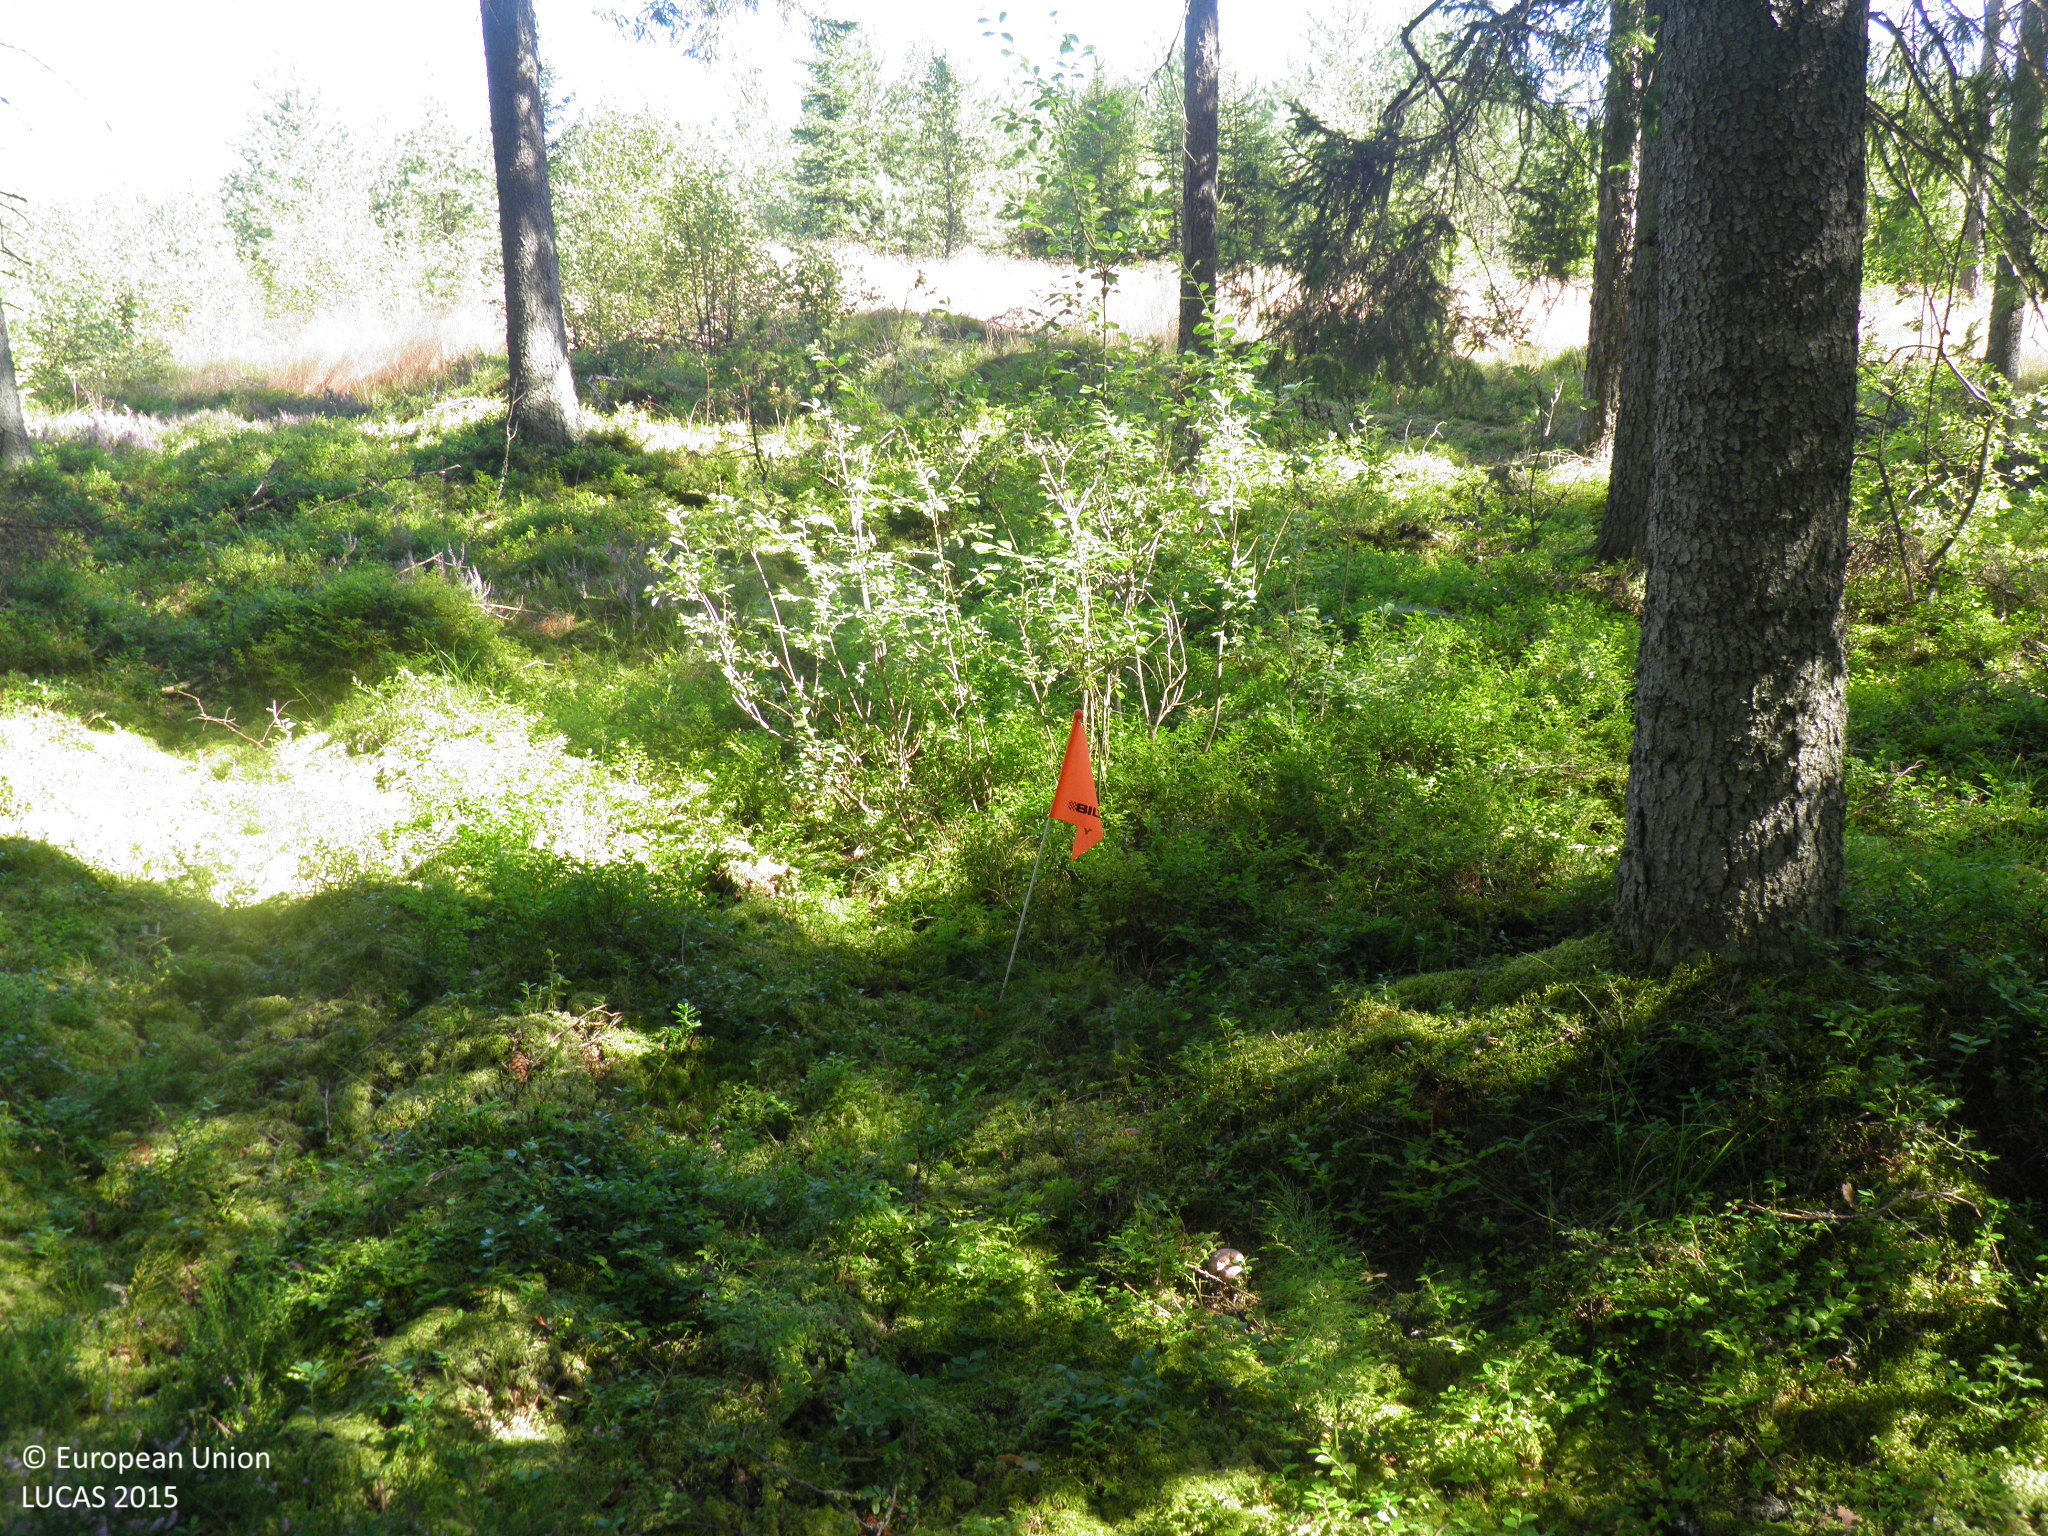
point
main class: Woodland
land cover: Spruce dominated coniferous woodland
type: hemiboreal forest and nemoral coniferous forest and mixed broadleaved-coniferous forest
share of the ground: > 75 %
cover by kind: coniferous forest trees 75 %, shrubs 25 %
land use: Forestry
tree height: > 5 m
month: August
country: FI
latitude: 60.7753
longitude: 21.6056
